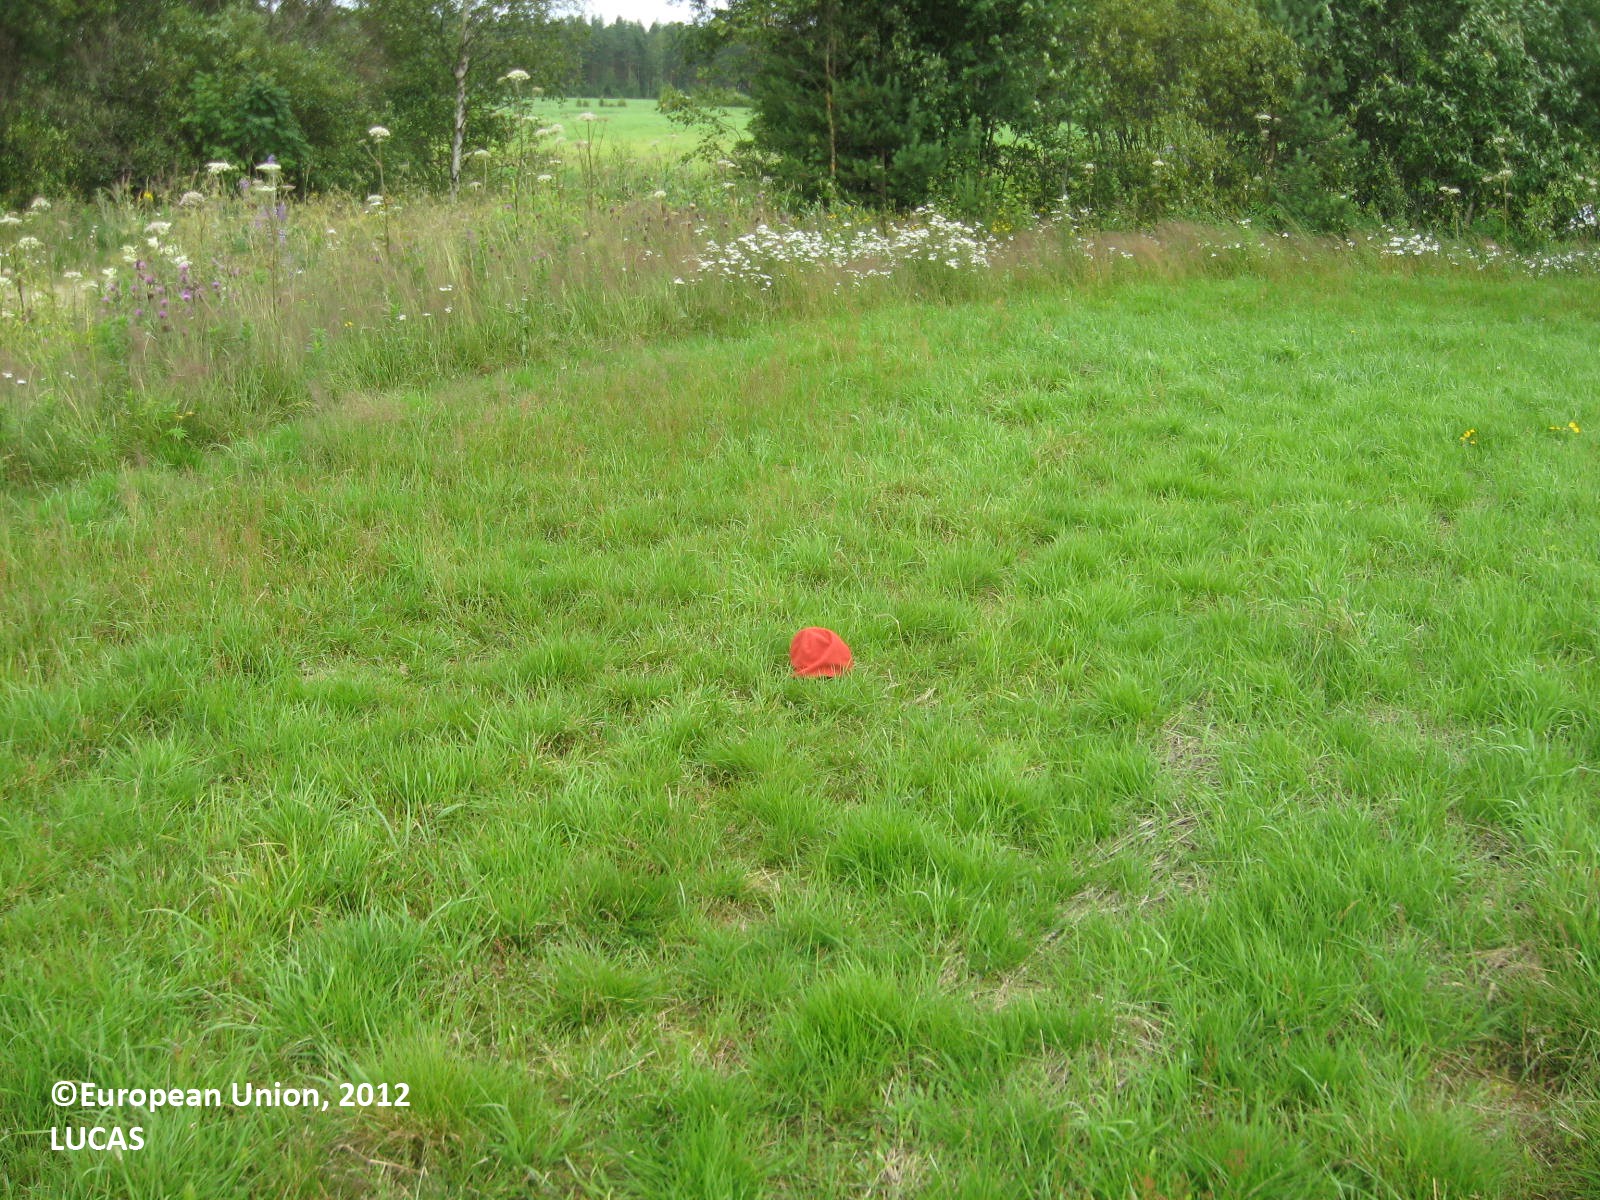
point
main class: Cropland
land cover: Temporary grasslands
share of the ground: > 75 %
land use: Agriculture (excluding fallow land and kitchen gardens)
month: July
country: FI
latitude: 62.1946
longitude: 22.7640
